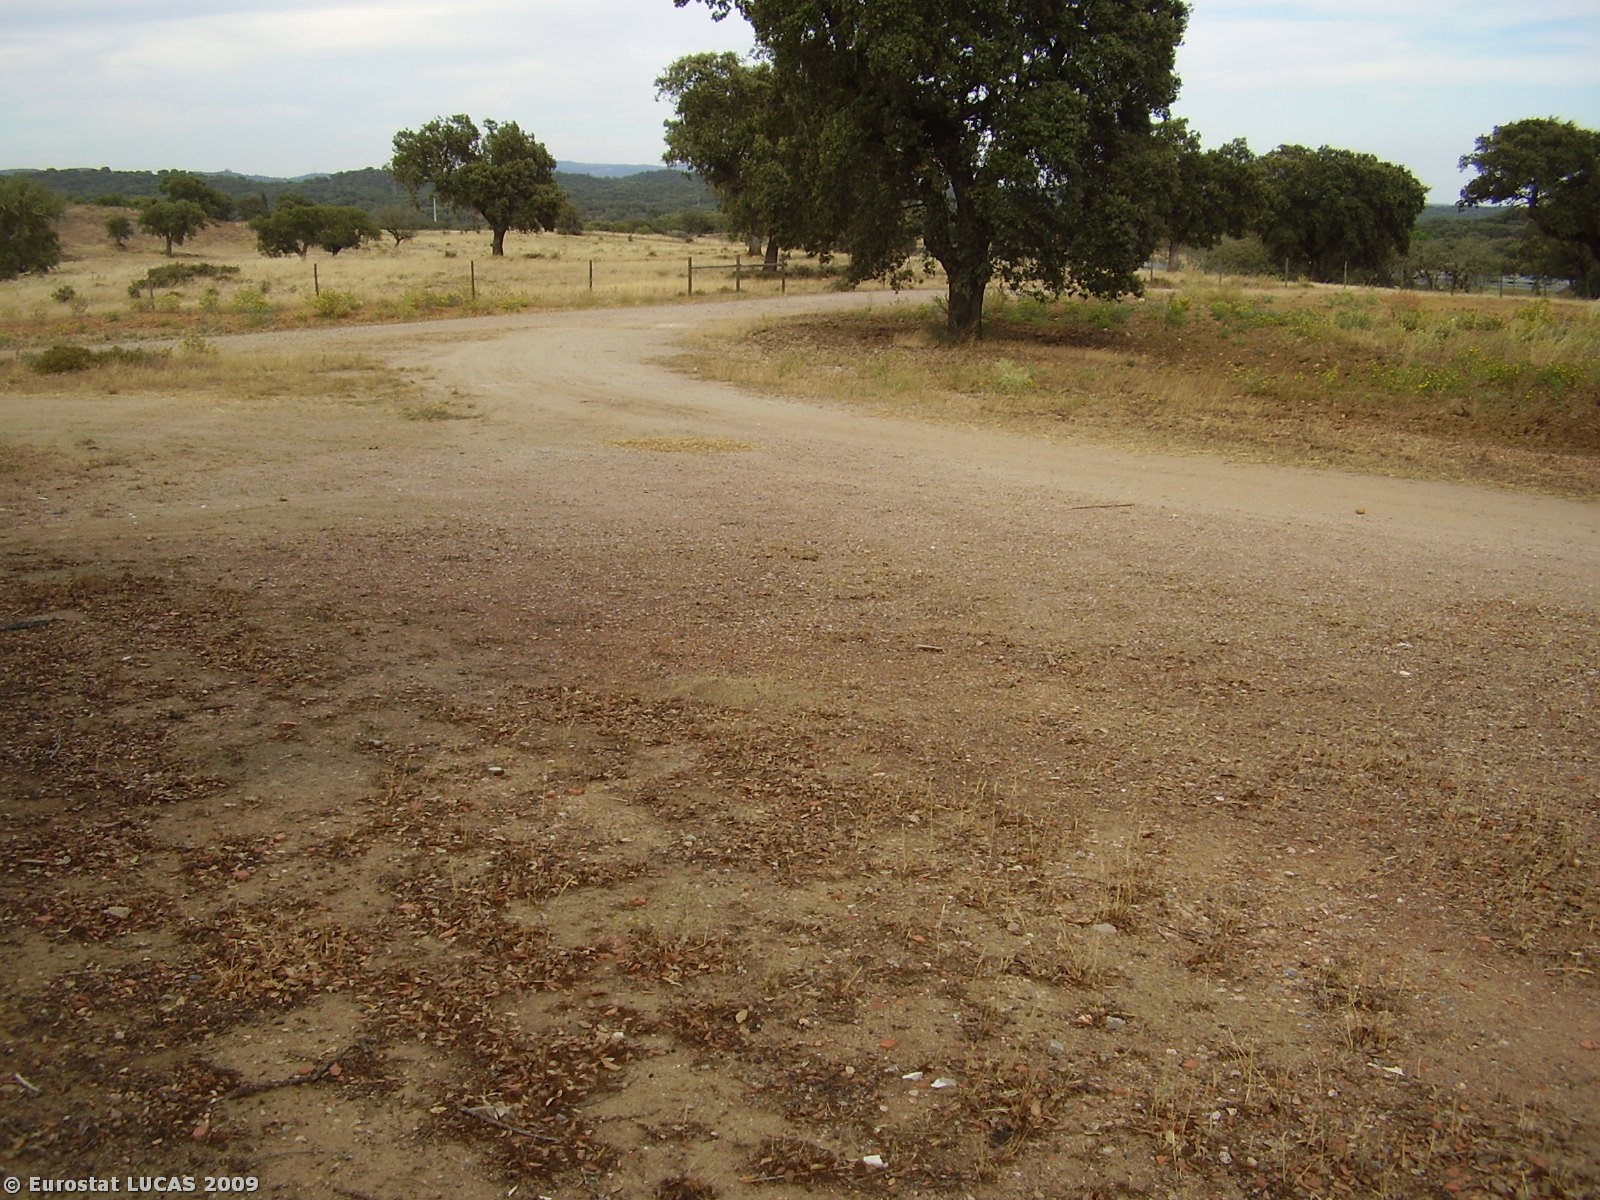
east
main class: Woodland
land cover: Broadleaved woodland
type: broadleaved evergreen forest
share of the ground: 10 - 25 %
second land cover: Bare land
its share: 50 - 75 %
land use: Forestry
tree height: > 5 m
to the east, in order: Broadleaved woodland; Bare land; Broadleaved woodland; Tracks; Broadleaved woodland; Tracks; Fences; Broadleaved woodland; Fences; Bare land; Broadleaved woodland; Spontaneously vegetated surfaces
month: July
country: PT
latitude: 38.7197
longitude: -7.7861
